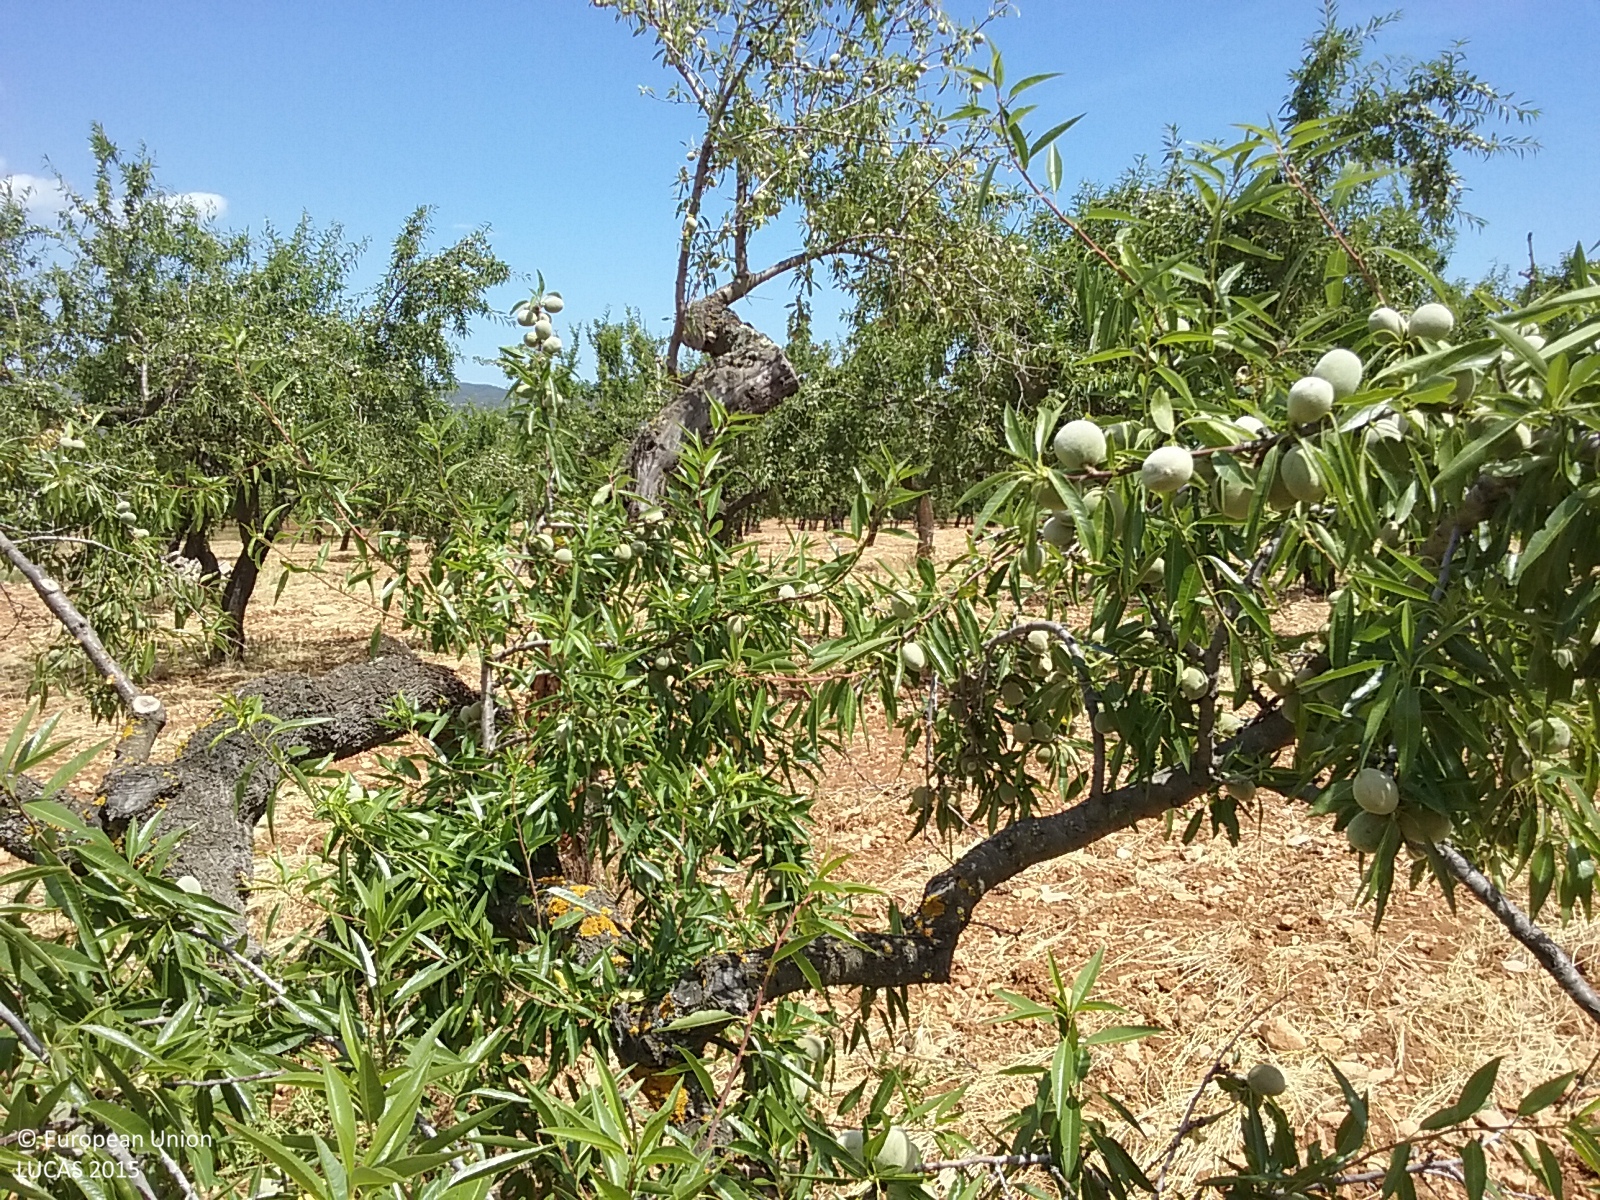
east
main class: Cropland
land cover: Nuts trees
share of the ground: 25 - 50 %
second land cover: Other bare soil
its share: > 75 %
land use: Agriculture (excluding fallow land and kitchen gardens)
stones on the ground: 10 - 25 %
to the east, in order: Nuts trees; Other bare soil; Dry stone walls; Nuts trees; Grass margins; Shrubland with sparse tree cover; Ditches and canals; Shrubland with sparse tree cover; Nuts trees
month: May
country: ES
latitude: 40.3477
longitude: 0.0949
